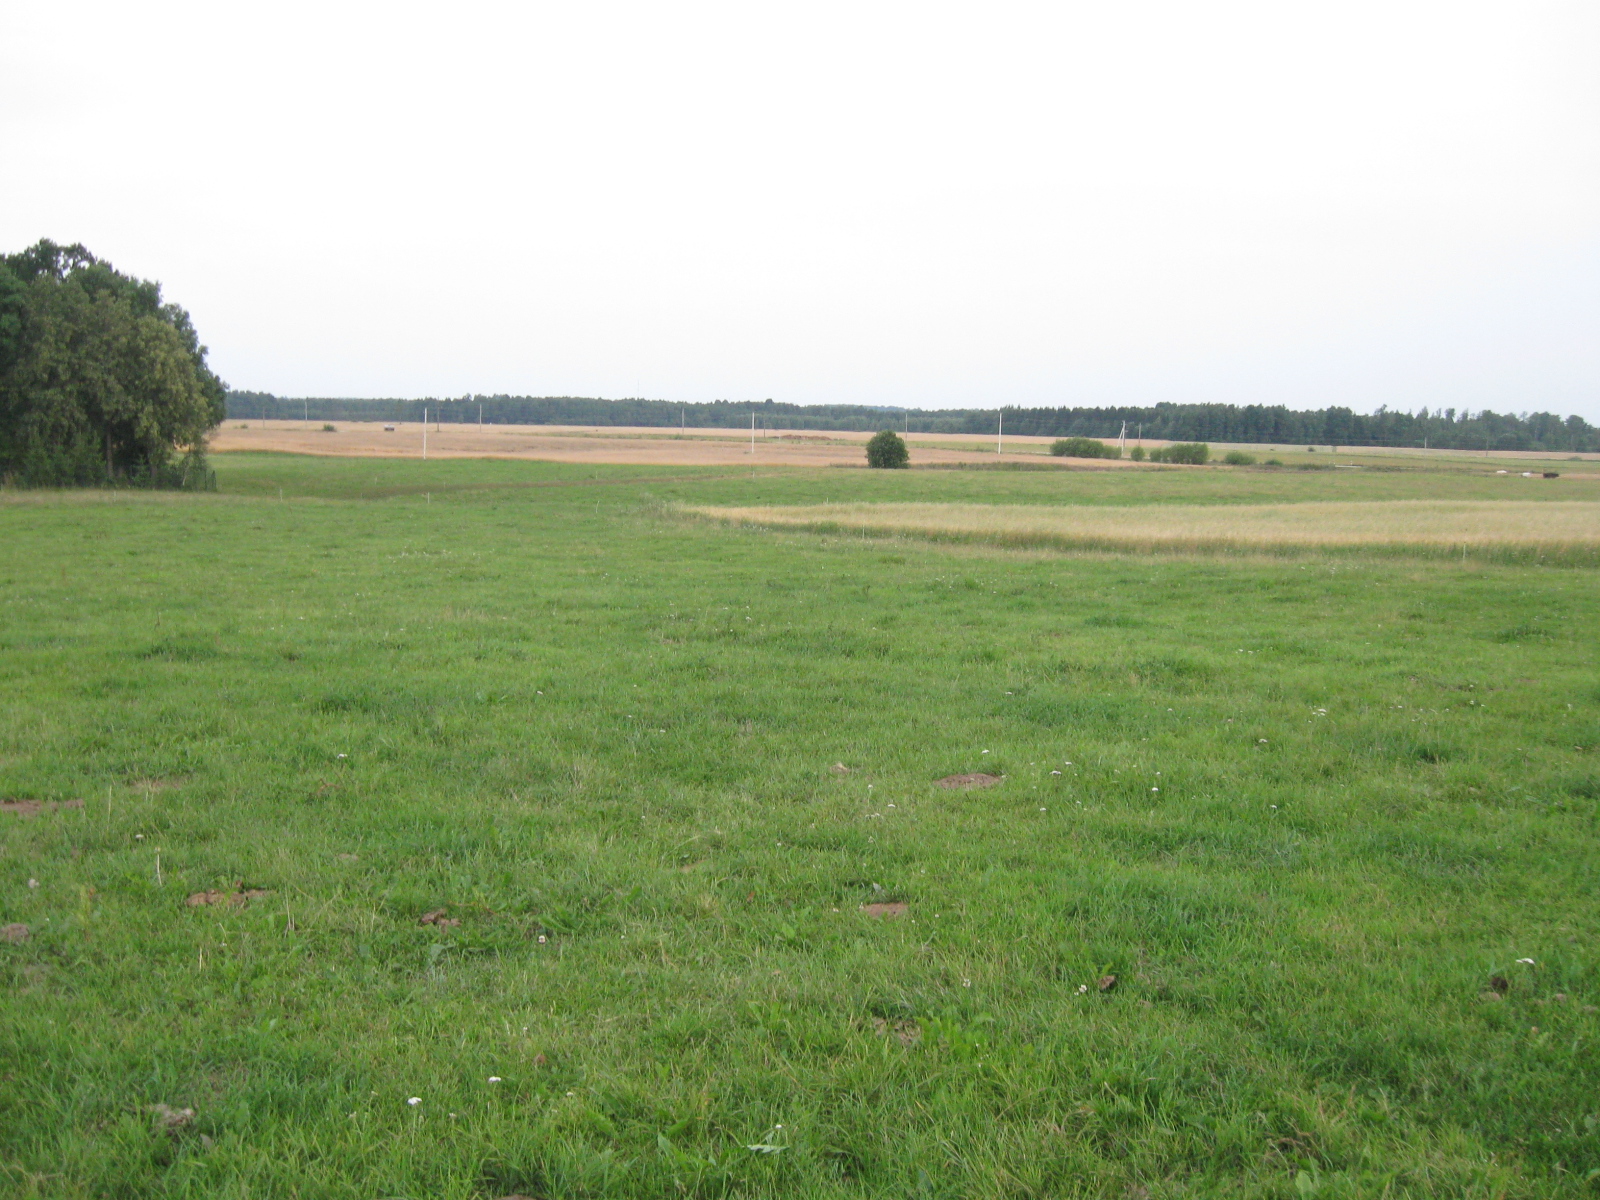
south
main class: Grassland
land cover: Grassland without tree/shrub cover
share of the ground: > 75 %
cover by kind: herbaceous plants 95 %, unconsolidated bare surface 5 %
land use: Agriculture (excluding fallow land and kitchen gardens)
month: July
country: LT
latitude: 54.7075
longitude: 23.7915
